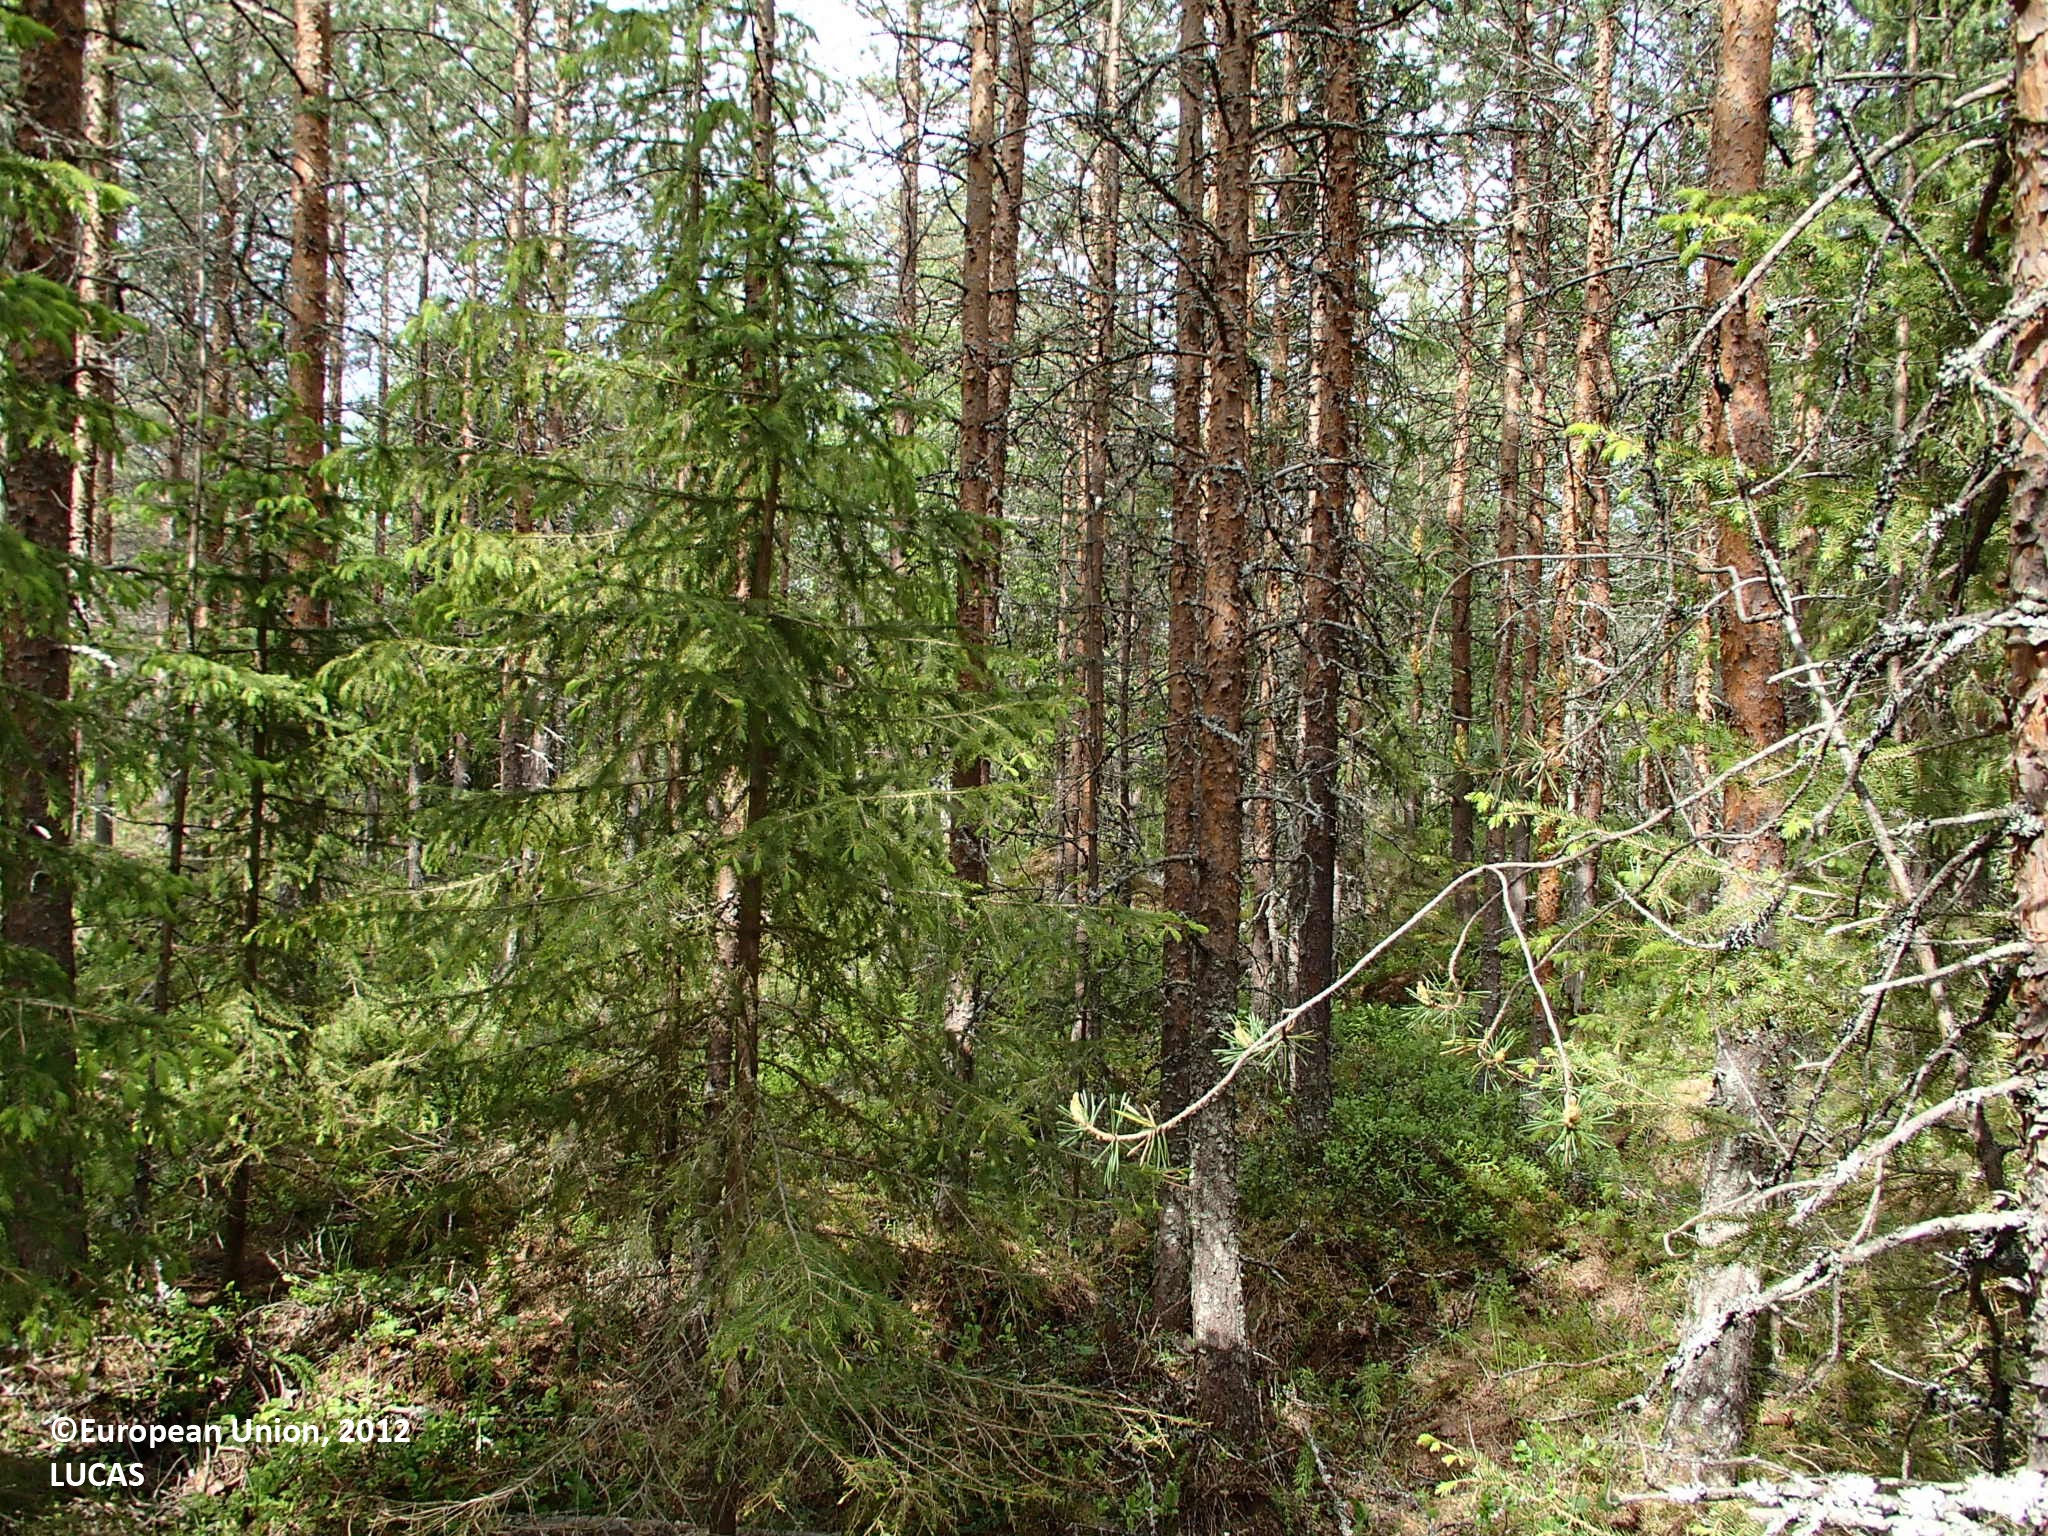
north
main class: Woodland
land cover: Pine dominated coniferous woodland
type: boreal forest
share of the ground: > 75 %
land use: Forestry
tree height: > 5 m
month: June
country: FI
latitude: 66.6041
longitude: 26.3535
